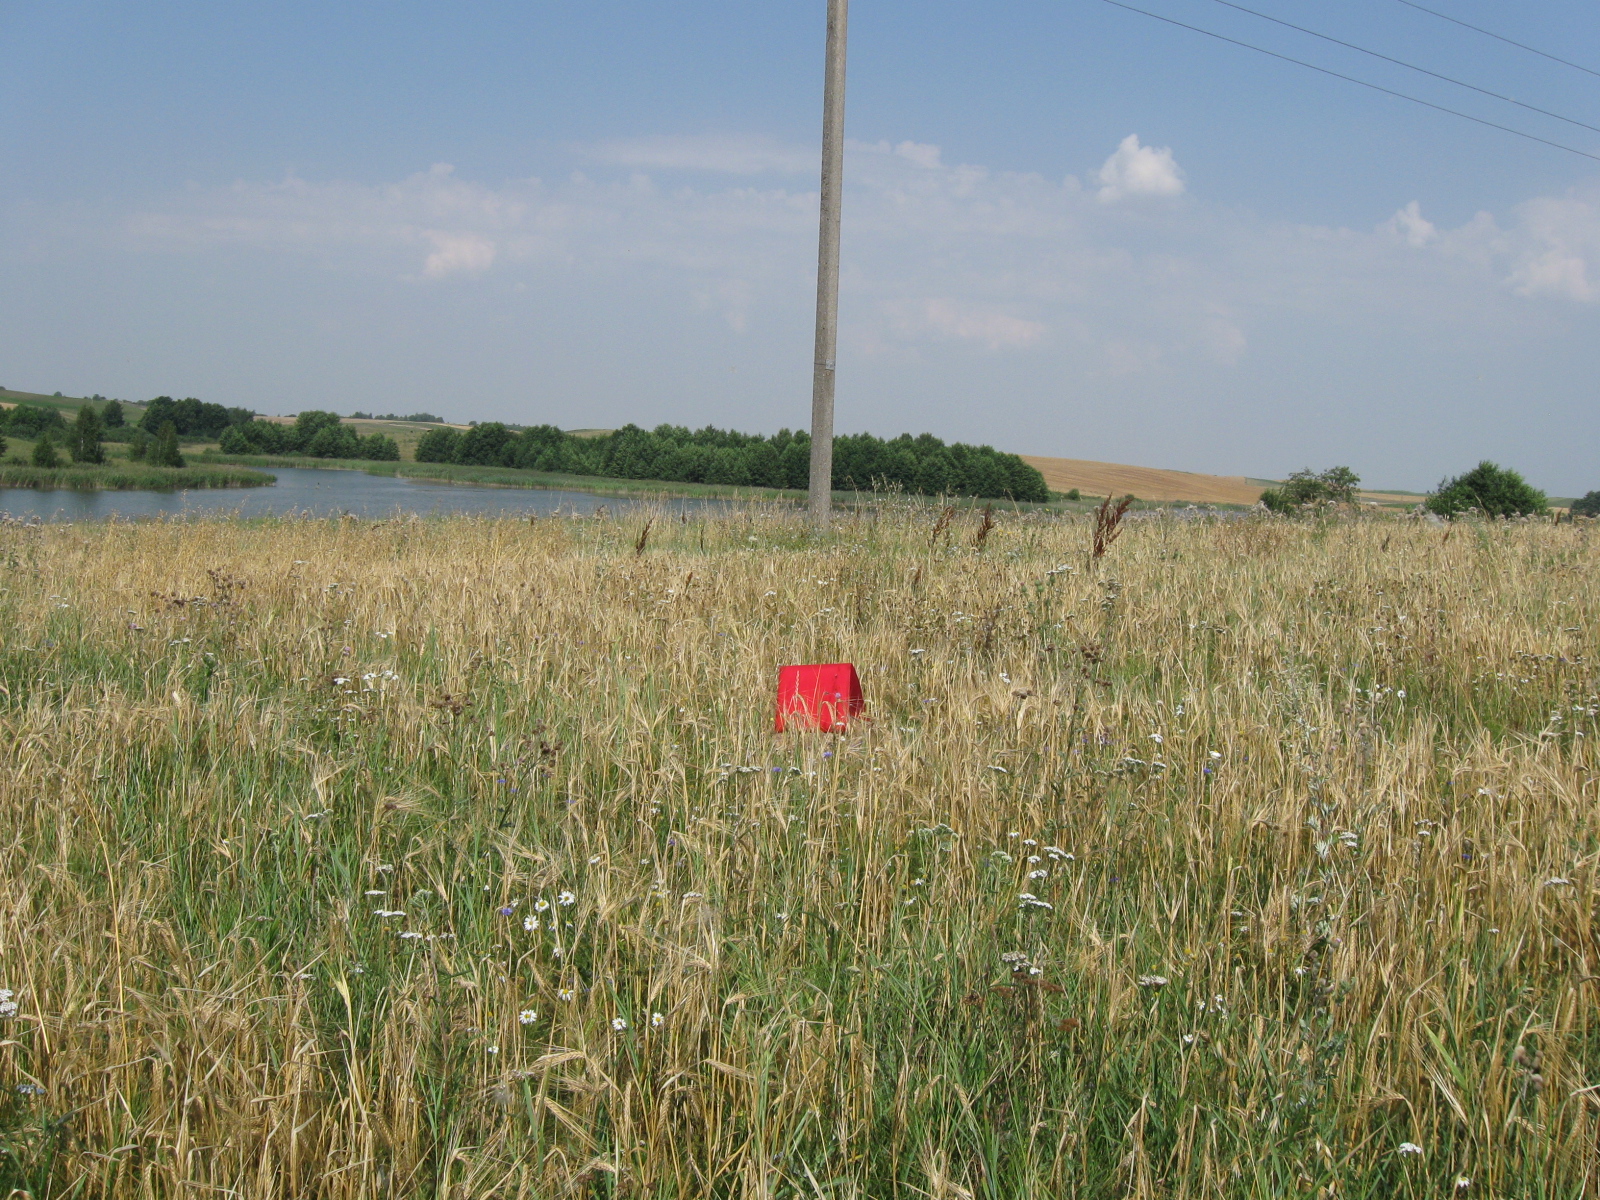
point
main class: Cropland
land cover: Barley
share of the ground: 50 - 75 %
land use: Agriculture (excluding fallow land and kitchen gardens)
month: August
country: LT
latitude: 54.3846
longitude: 23.2425
